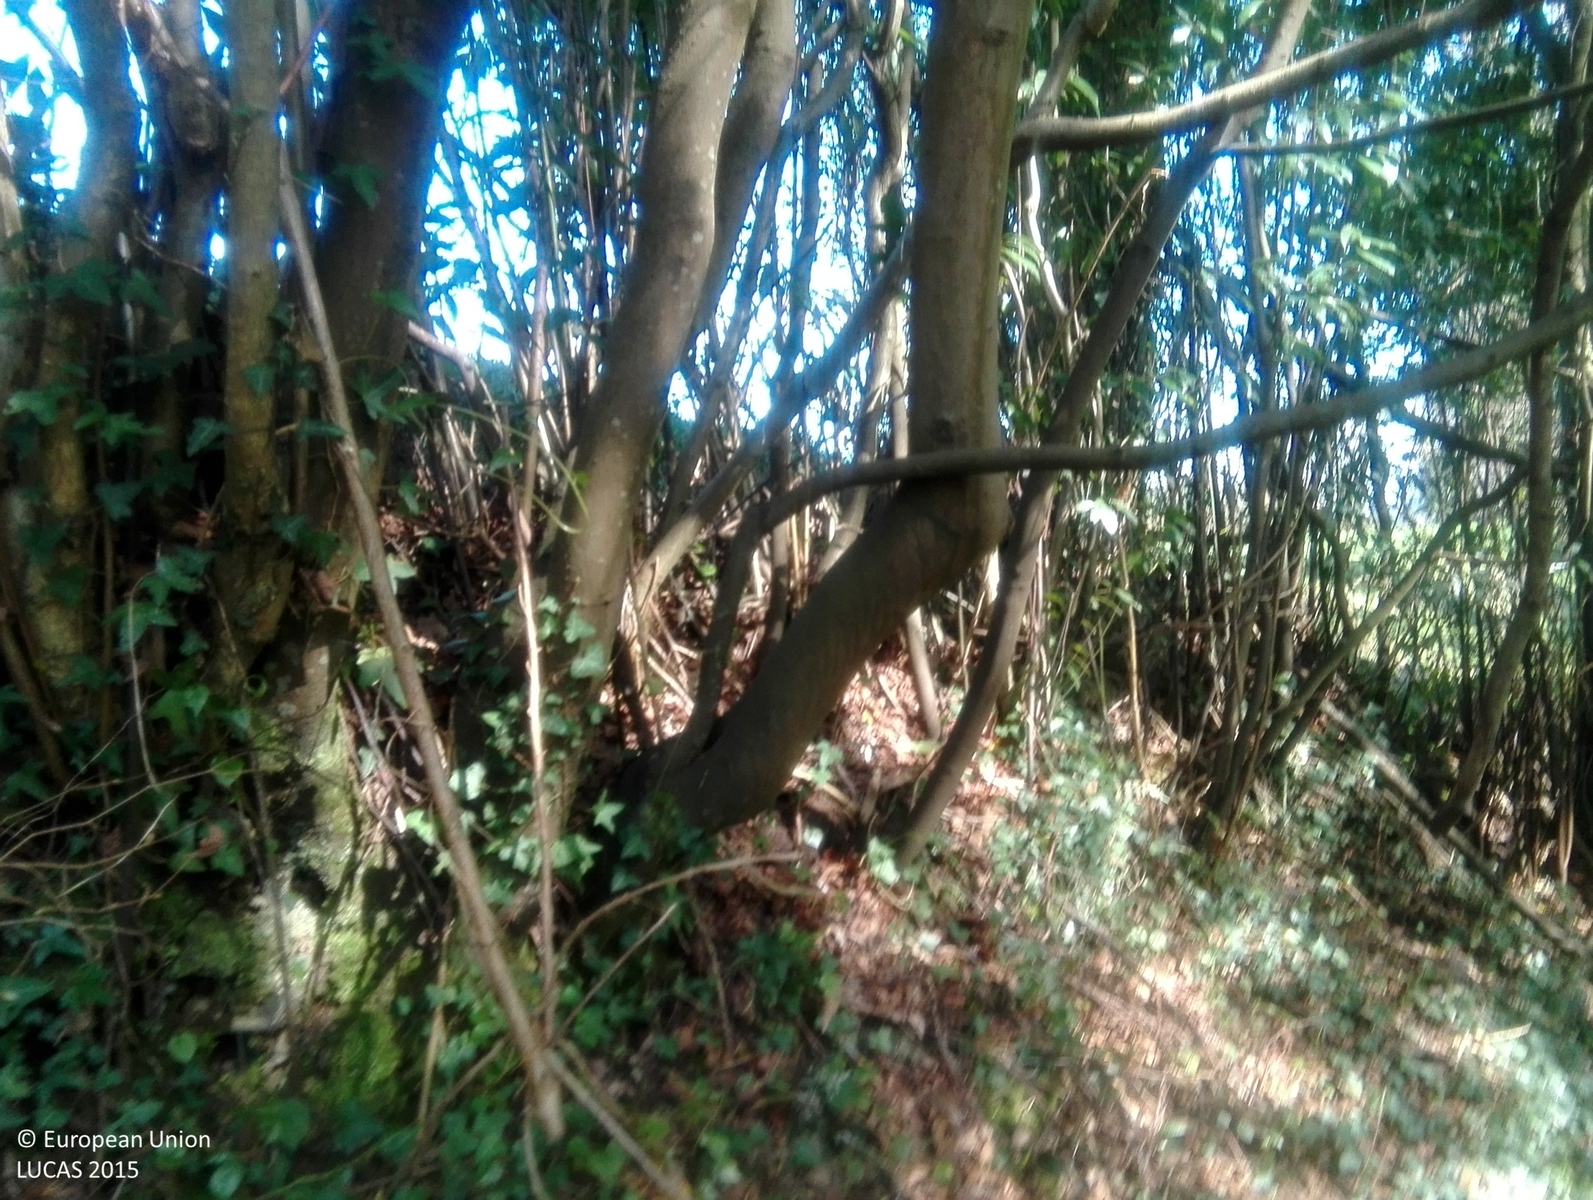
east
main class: Woodland
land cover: Broadleaved woodland
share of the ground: > 75 %
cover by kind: broadleaved forest trees 100 %
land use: Semi-natural and natural areas not in use
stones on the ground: < 10 %
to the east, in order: Broadleaved woodland; Fences; Grassland without tree/shrub cover; Managed hedges; Grassland with sparse tree/shrub cover; Dry stone walls; Grassland without tree/shrub cover; Managed hedges; Grassland with sparse tree/shrub cover; Artificial constructions in urban areas
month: April
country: ES
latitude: 43.4139
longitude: -5.6320
